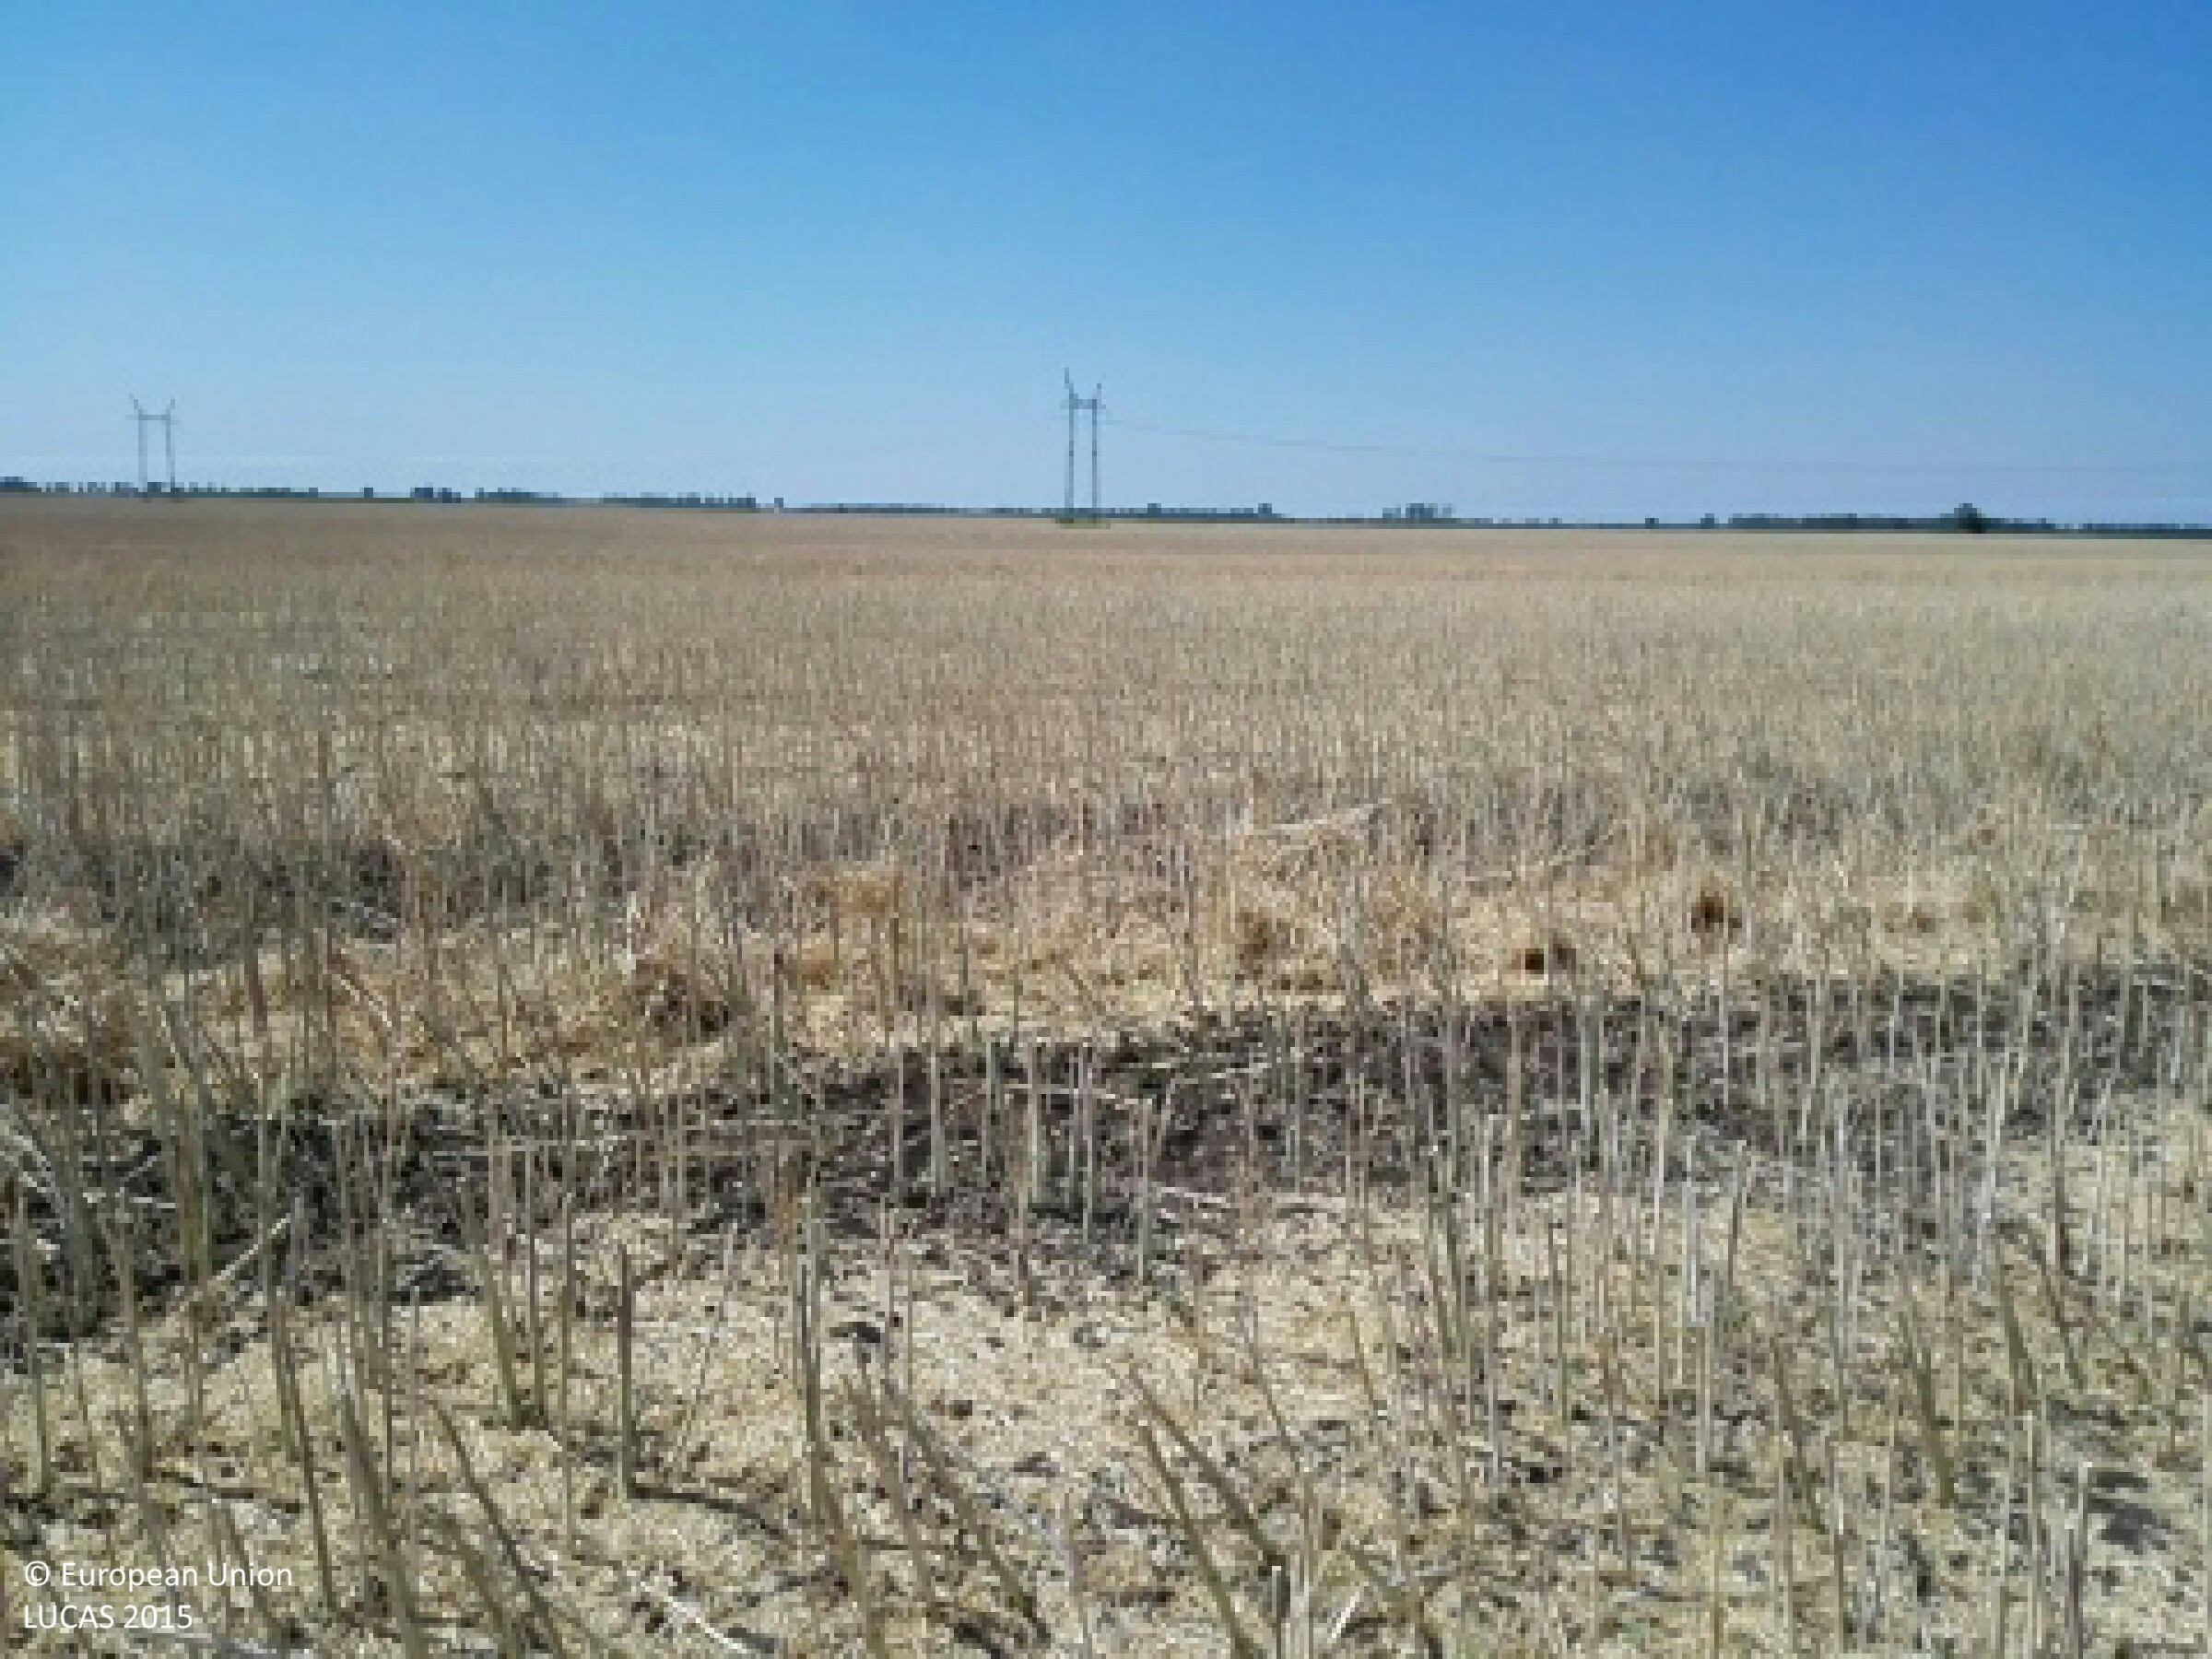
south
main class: Cropland
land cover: Rape and turnip rape
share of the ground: > 75 %
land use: Agriculture (excluding fallow land and kitchen gardens)
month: July
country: HU
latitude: 47.7522
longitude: 21.4482
